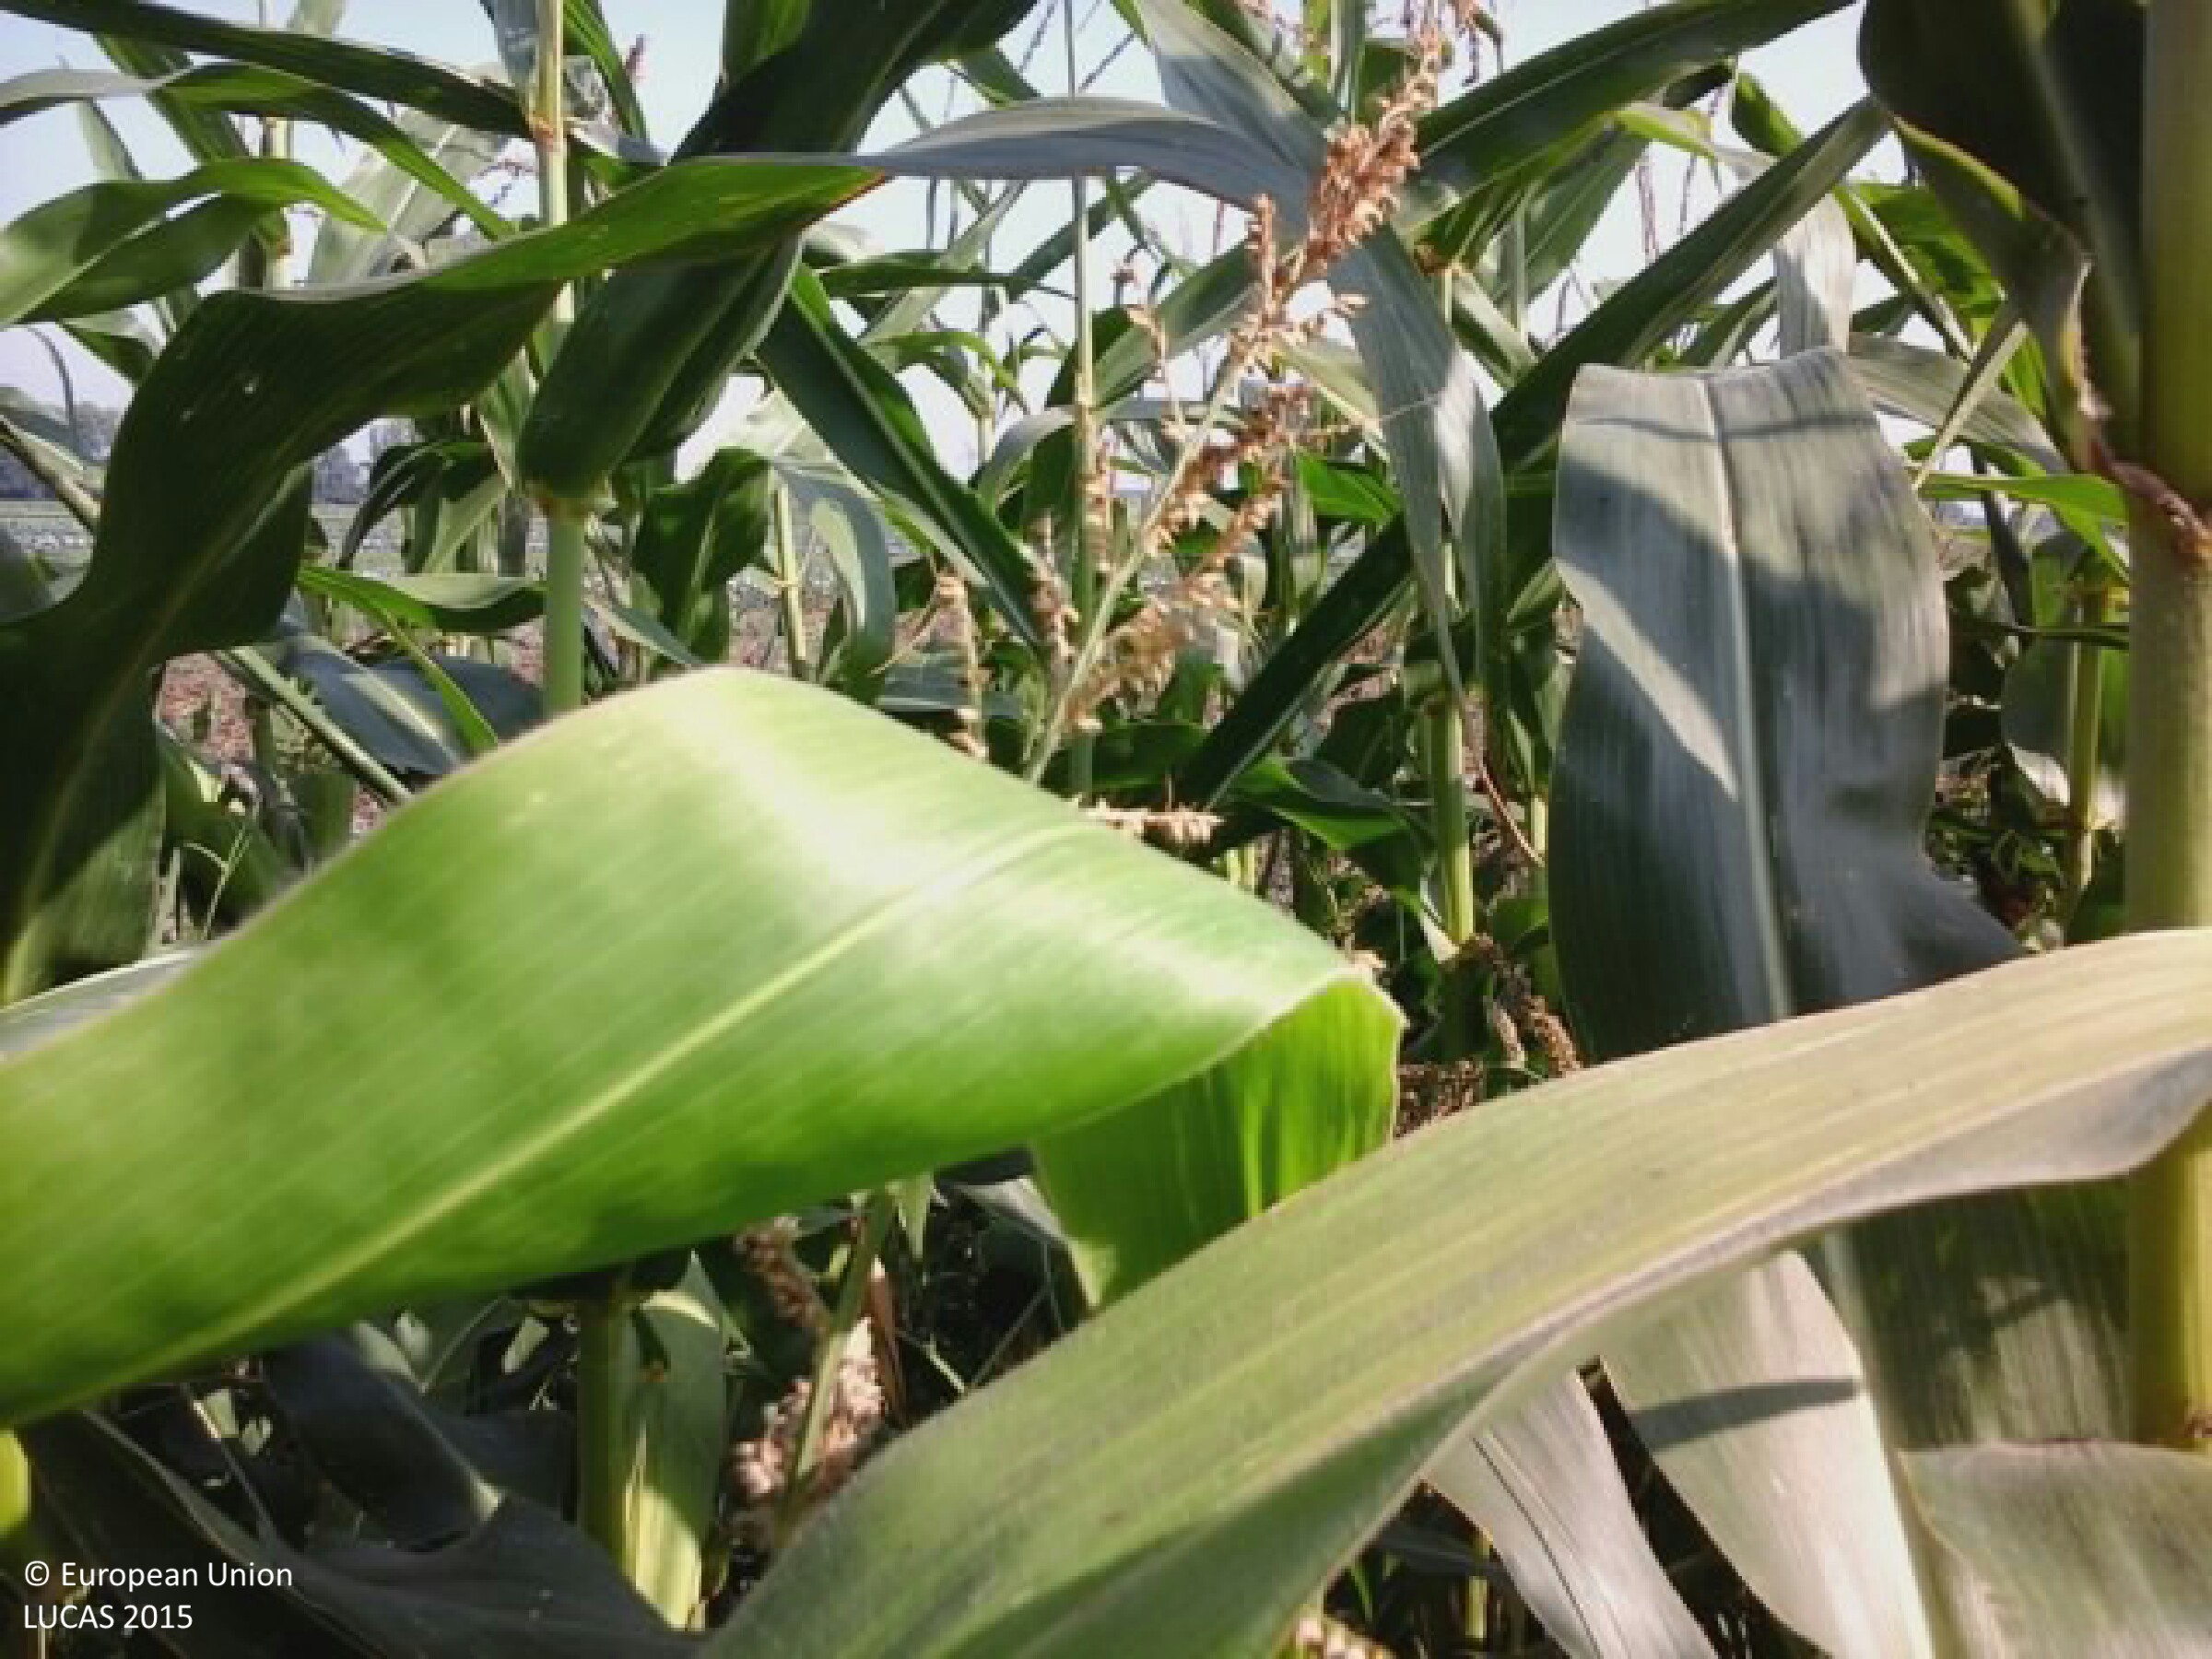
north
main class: Cropland
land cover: Maize
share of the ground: > 75 %
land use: Agriculture (excluding fallow land and kitchen gardens)
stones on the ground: < 10 %
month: August
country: HU
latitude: 47.3007
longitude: 19.1300
